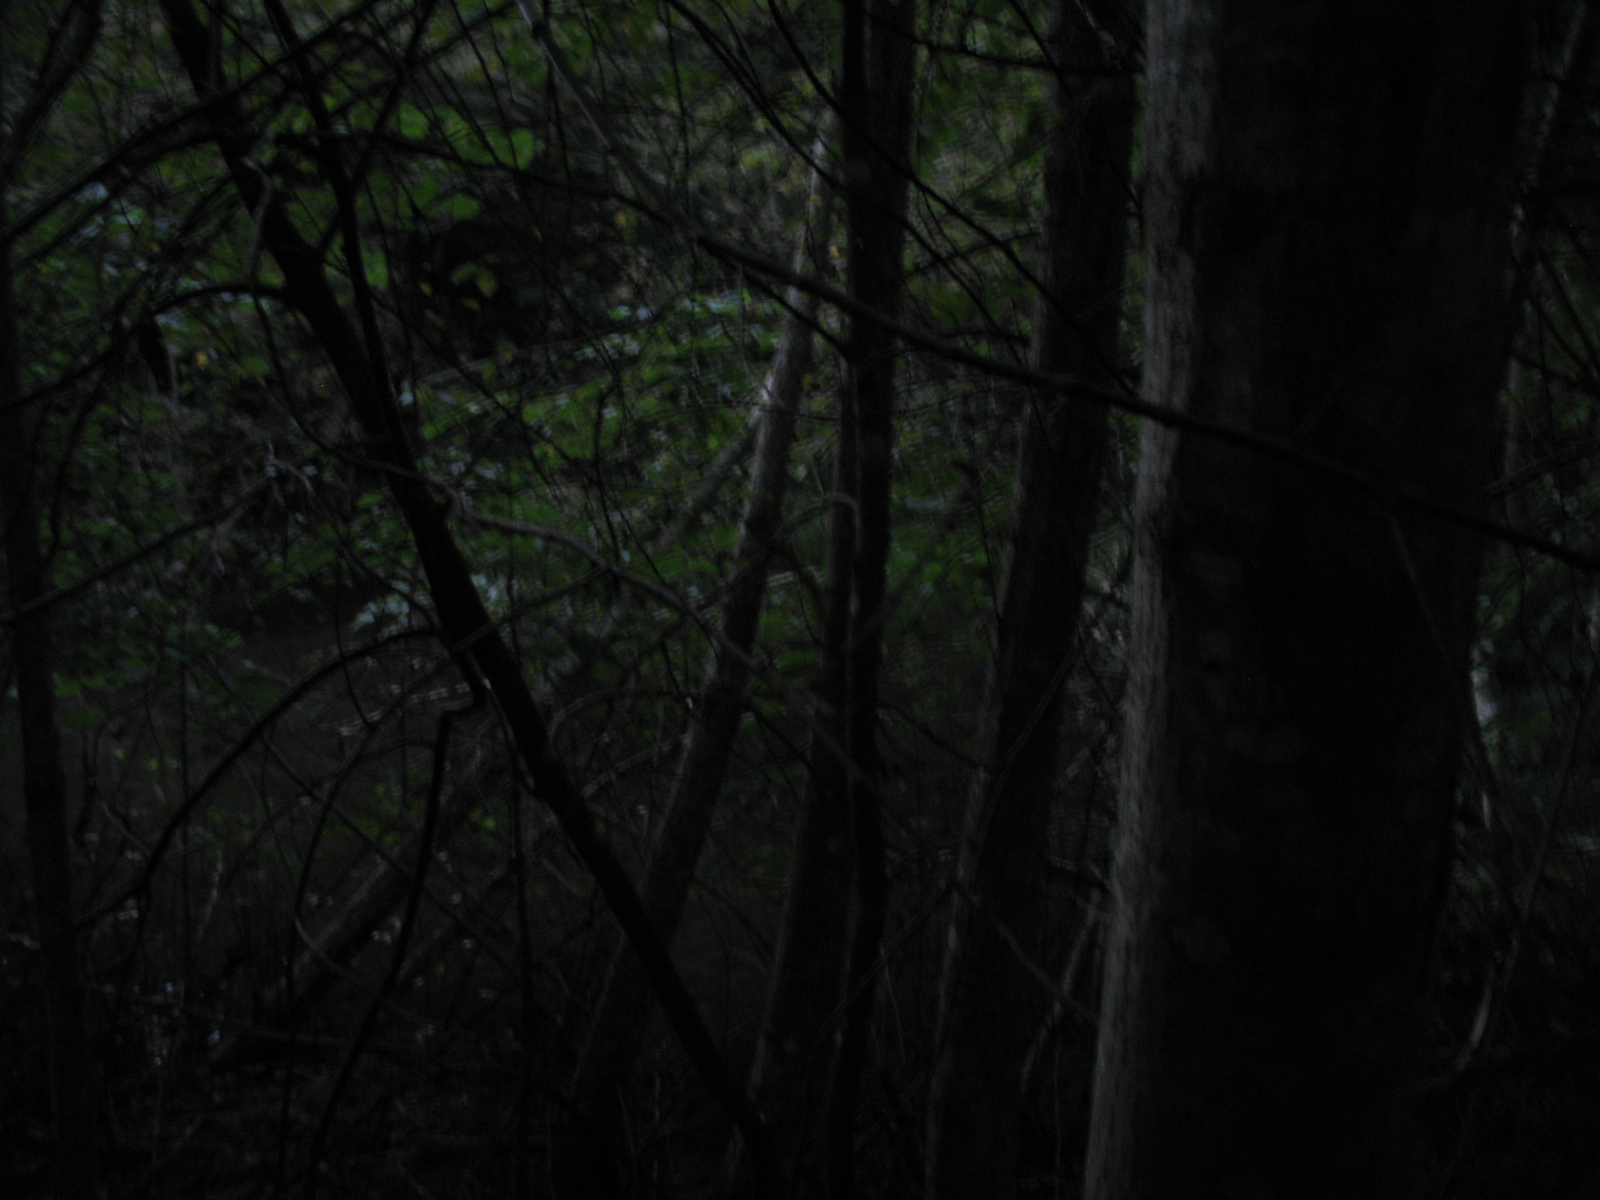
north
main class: Woodland
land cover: Broadleaved woodland
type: non-riverine alder, birch or aspen forest
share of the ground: > 75 %
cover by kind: broadleaved forest trees 90 %, unconsolidated bare surface 5 %
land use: Forestry
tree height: > 5 m
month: August
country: LV
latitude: 56.4702
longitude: 25.6257
